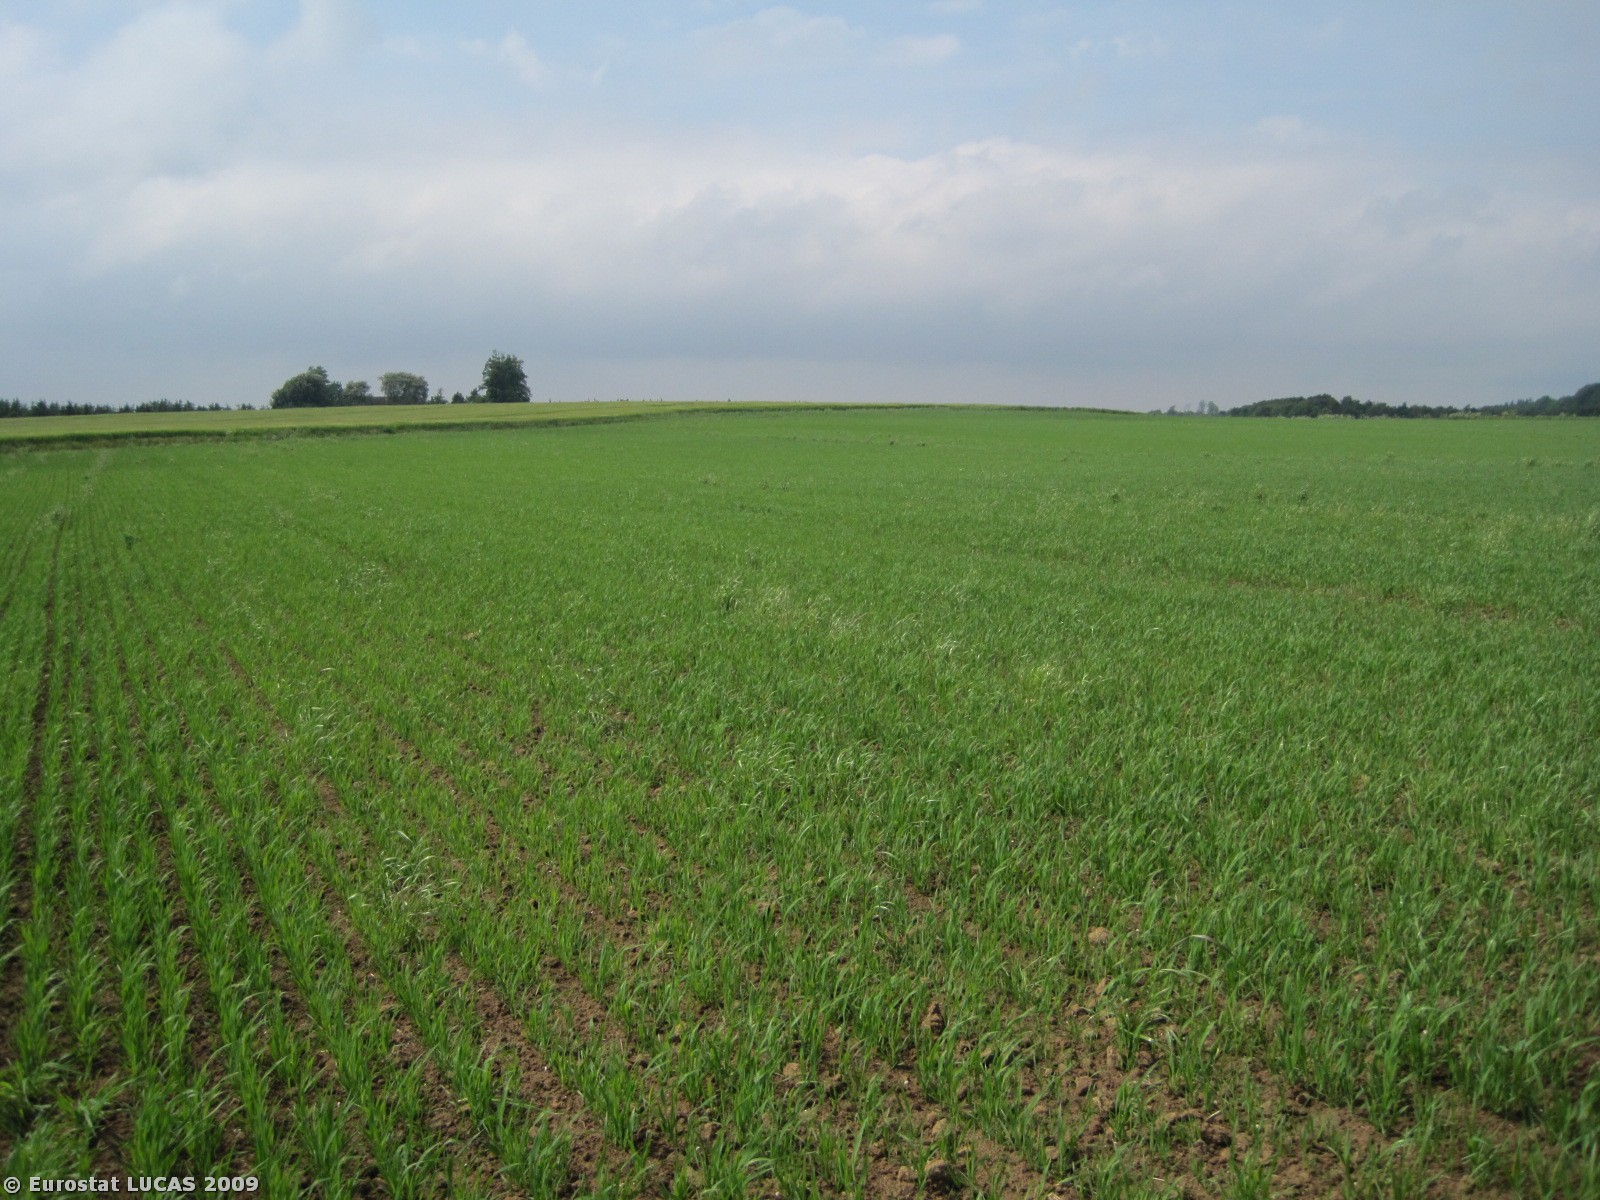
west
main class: Cropland
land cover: Oats
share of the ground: > 75 %
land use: Agriculture (excluding fallow land and kitchen gardens)
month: May
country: DK
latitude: 56.4213
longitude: 9.7895
